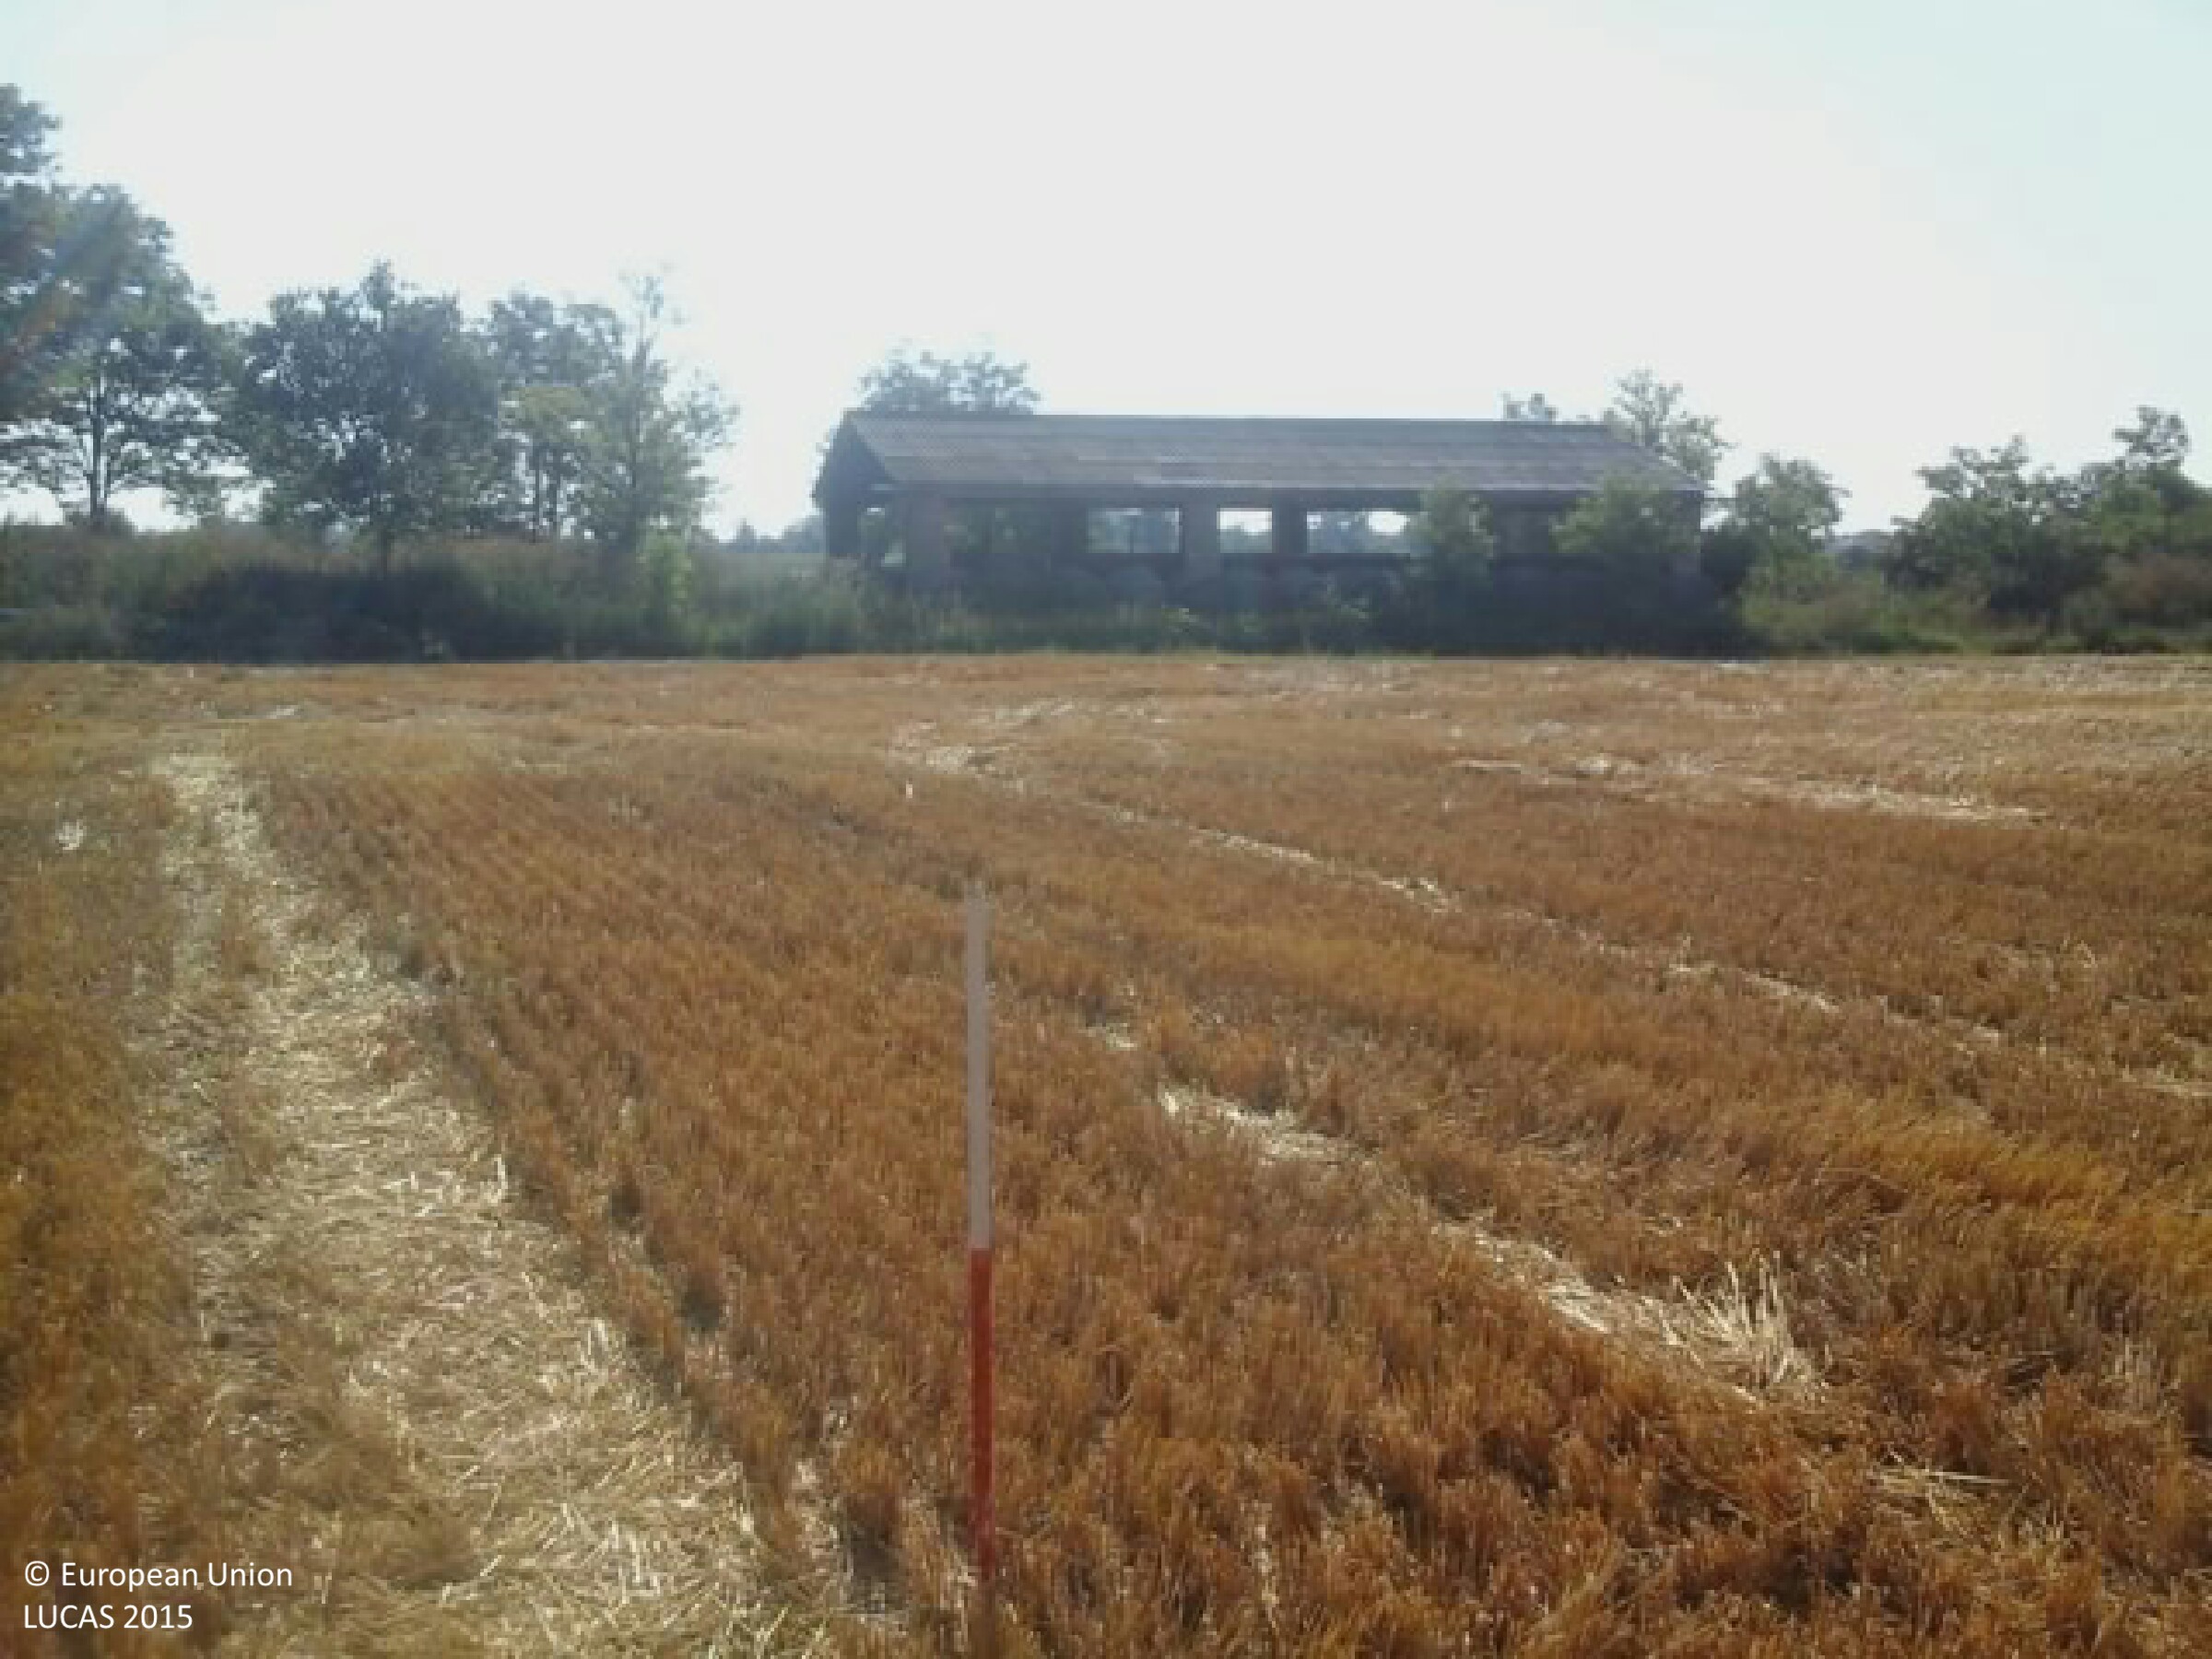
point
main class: Cropland
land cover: Barley
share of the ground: 25 - 50 %
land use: Agriculture (excluding fallow land and kitchen gardens)
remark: Harvested field
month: July
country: HU
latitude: 46.0421
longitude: 19.0187
